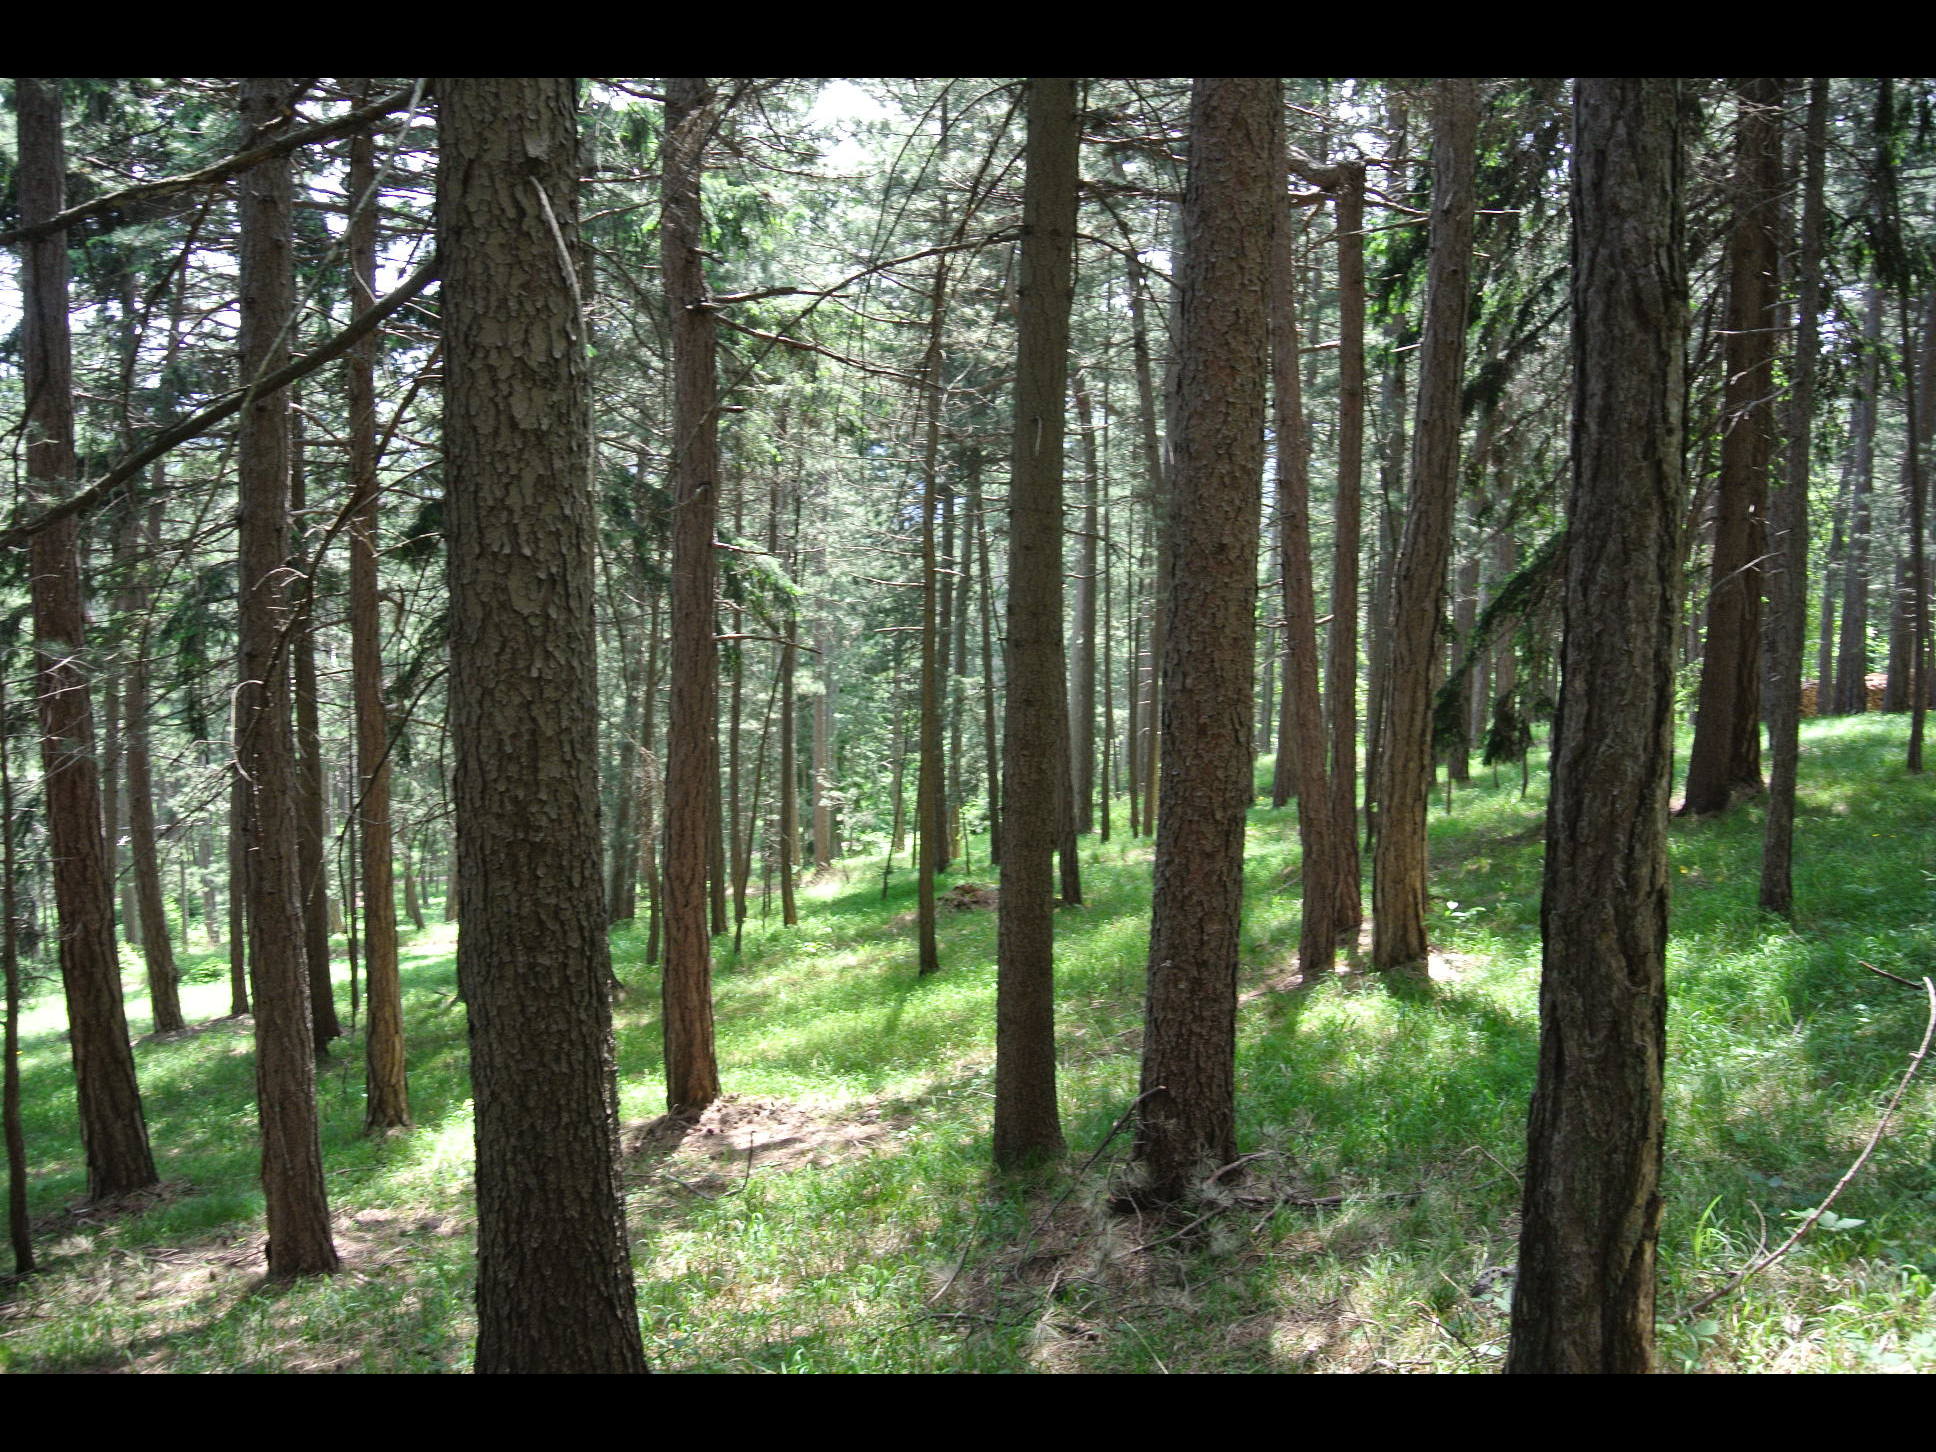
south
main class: Woodland
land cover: Pine dominated coniferous woodland
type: alpine coniferous forest
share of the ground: > 75 %
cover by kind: coniferous forest trees 85 %, herbaceous plants 15 %
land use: Forestry
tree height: > 5 m
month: May
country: AT
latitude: 47.8061
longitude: 16.0251
